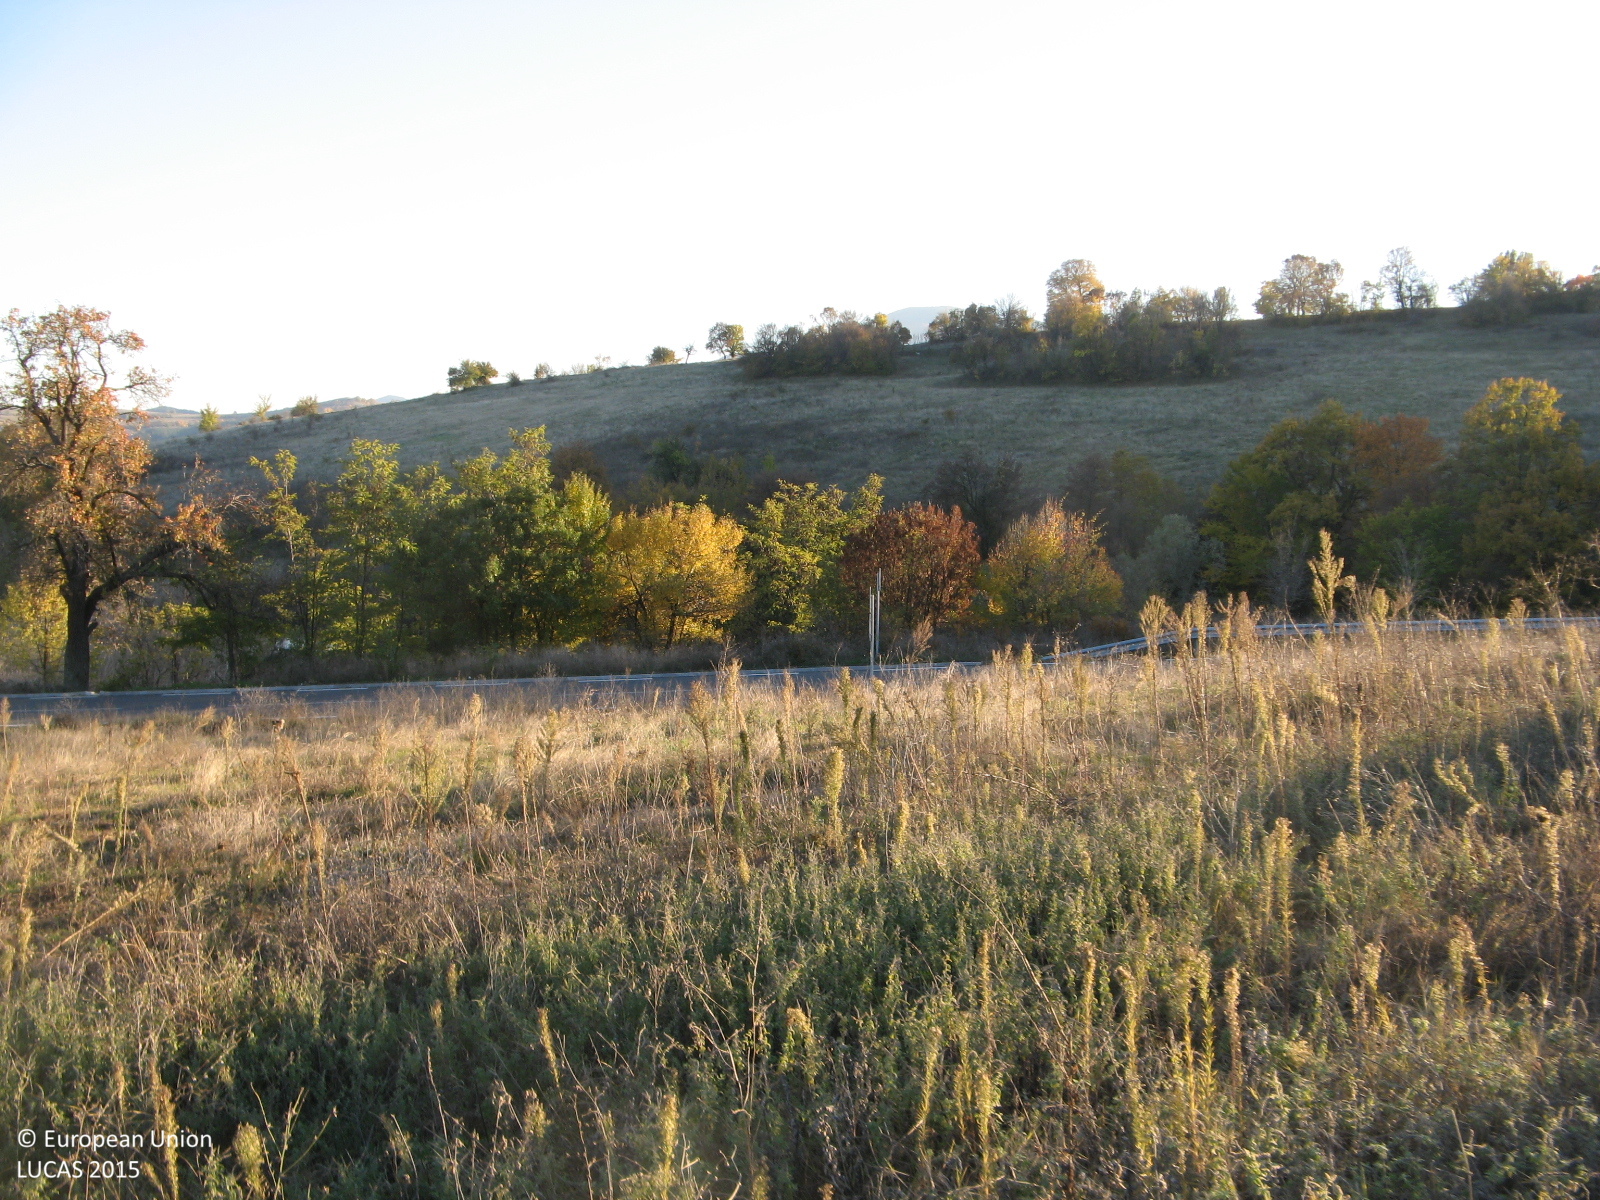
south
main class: Grassland
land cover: Spontaneously vegetated surfaces
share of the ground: > 75 %
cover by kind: herbaceous plants 100 %
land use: Fallow land
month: November
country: BG
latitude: 41.7559
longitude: 25.3195
